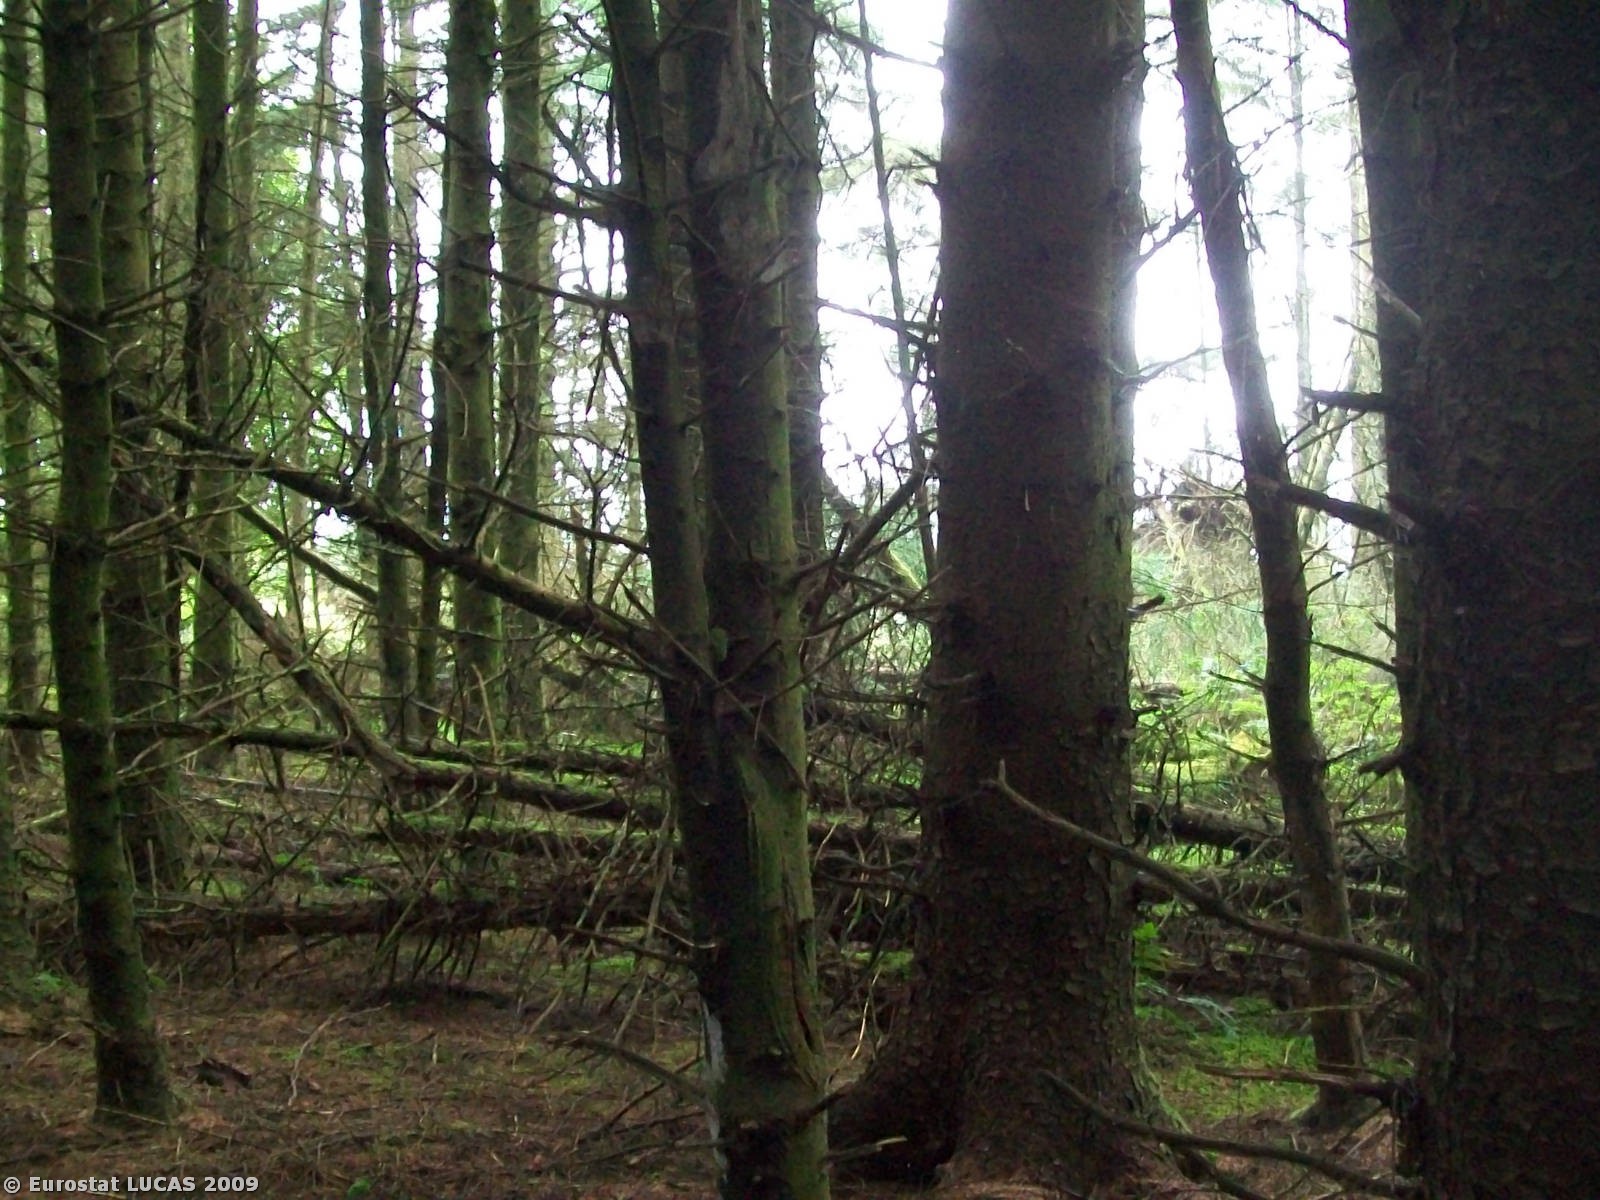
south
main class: Woodland
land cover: Coniferous woodland
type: plantations and self-sown exotic forest
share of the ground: > 75 %
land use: Forestry
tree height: > 5 m
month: July
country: GB
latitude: 54.9755
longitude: -6.8020
